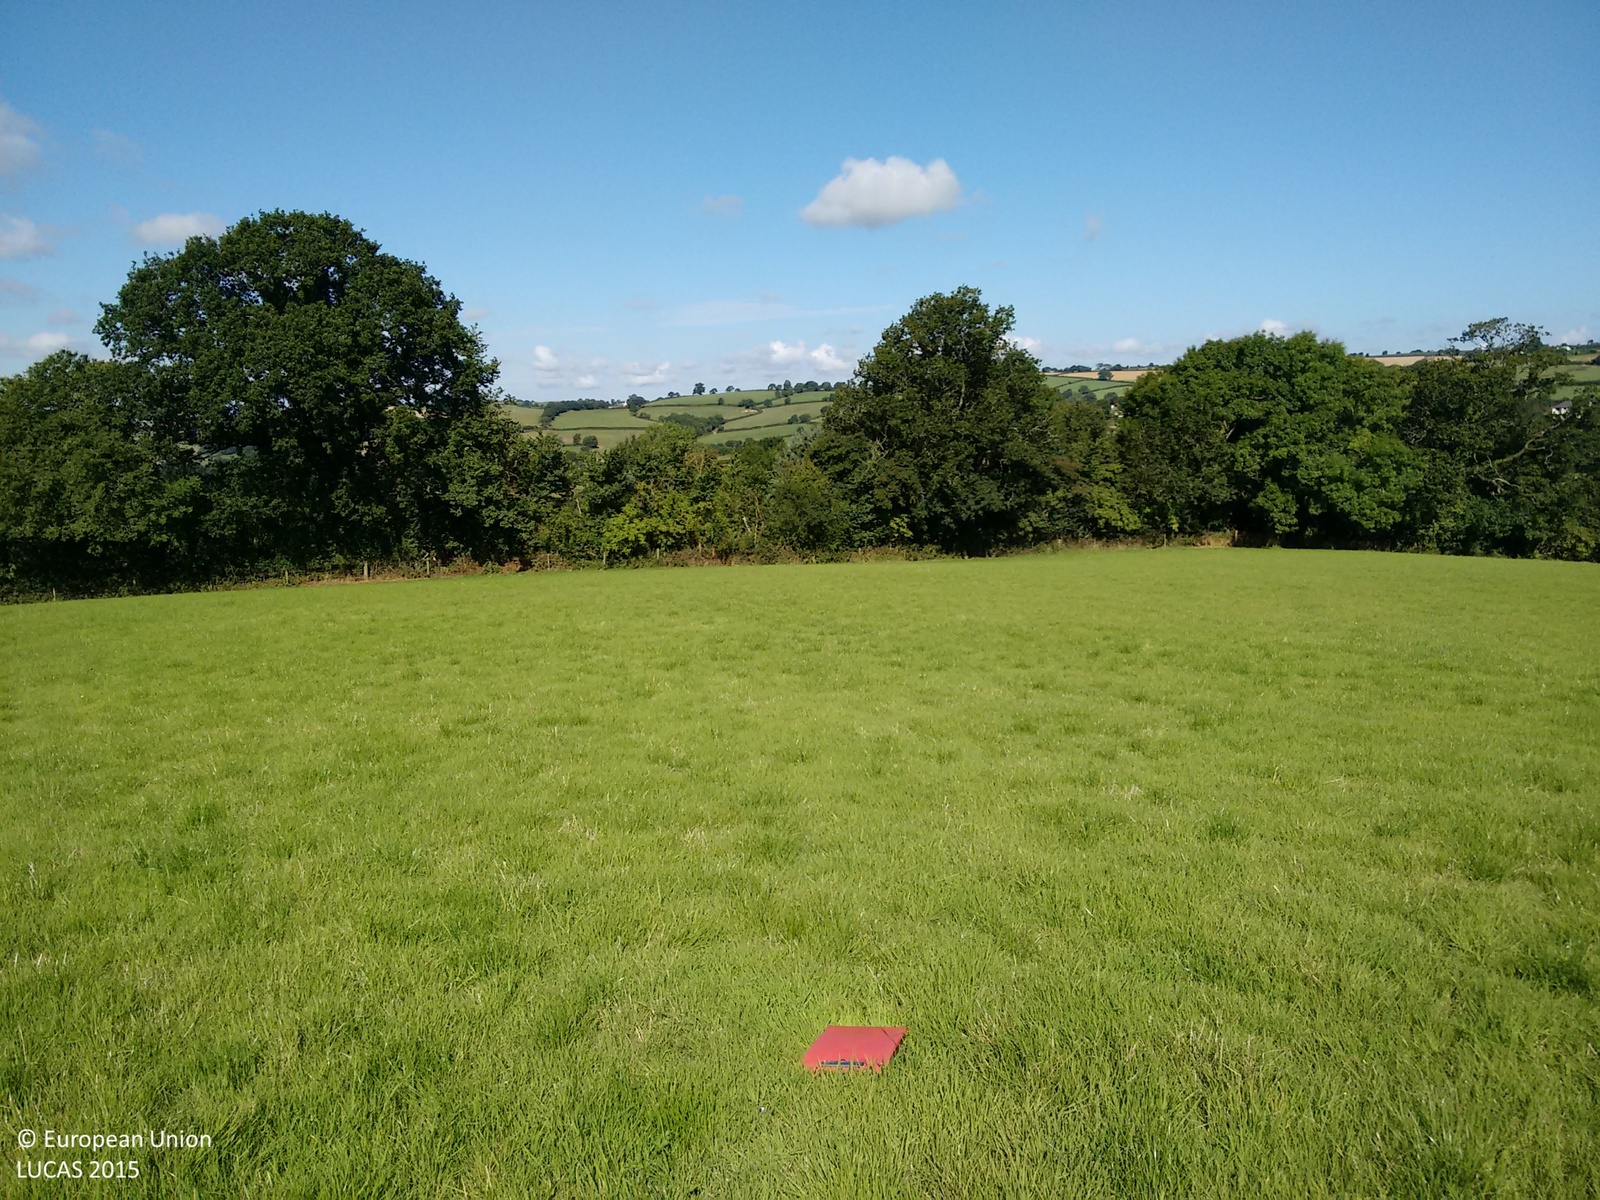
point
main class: Grassland
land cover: Grassland without tree/shrub cover
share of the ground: > 75 %
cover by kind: herbaceous plants 100 %
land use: Agriculture (excluding fallow land and kitchen gardens)
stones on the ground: < 10 %
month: August
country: GB
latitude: 50.8595
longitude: -3.4517
